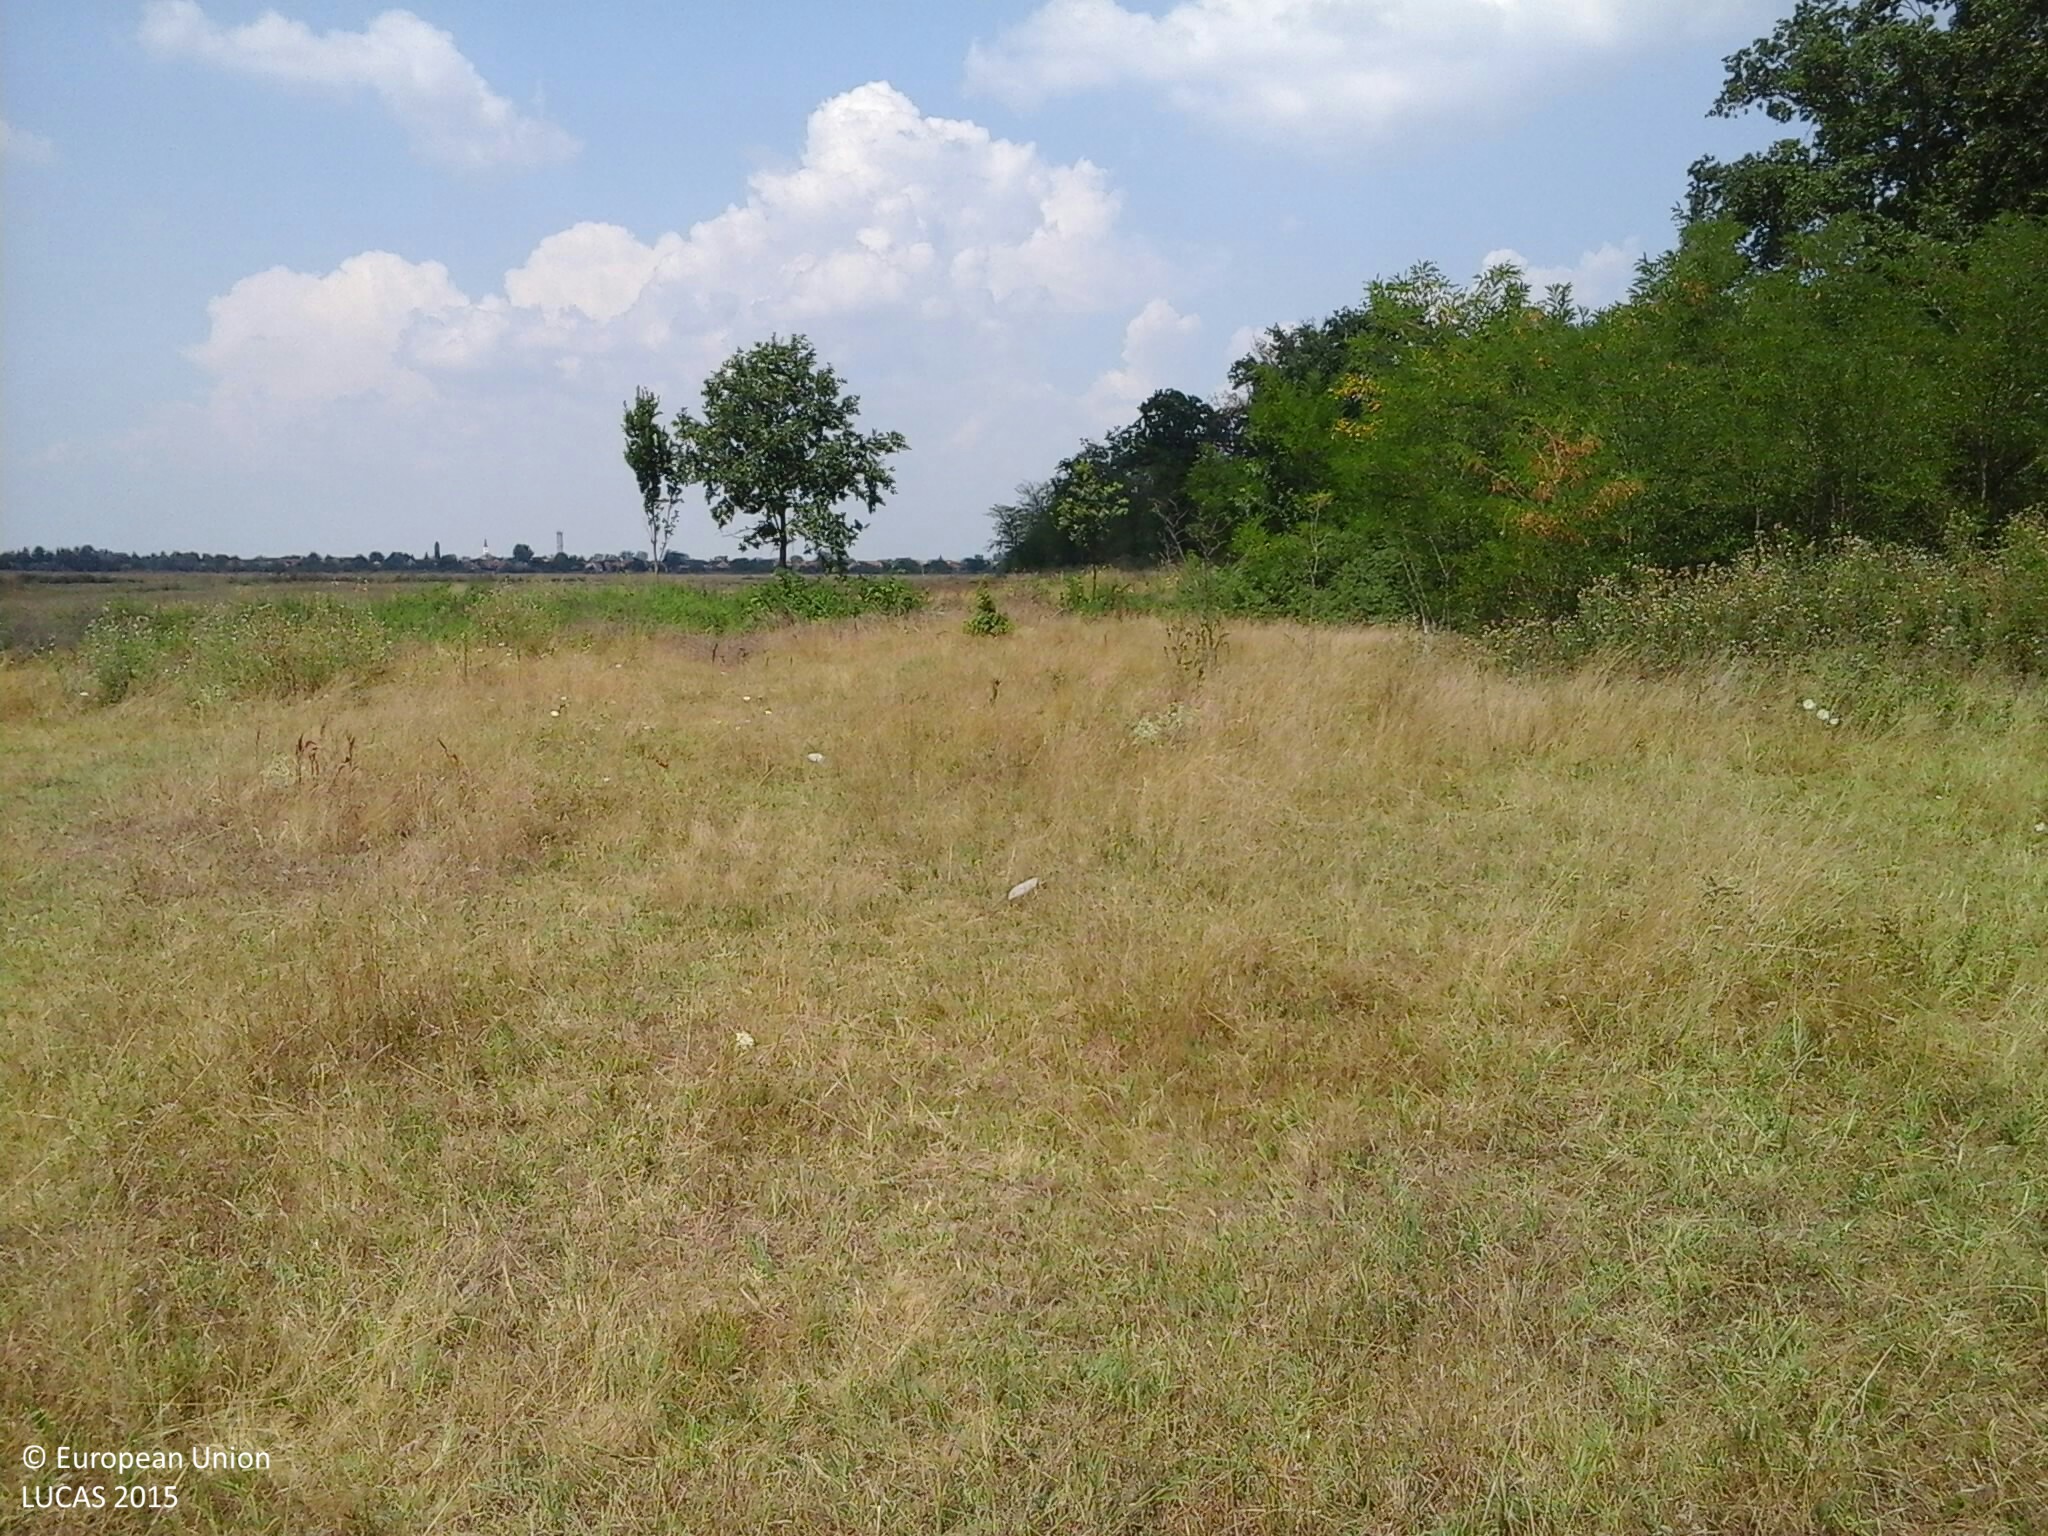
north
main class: Grassland
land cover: Grassland with sparse tree/shrub cover
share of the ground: > 75 %
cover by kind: herbaceous plants 90 %, broadleaved forest trees 5 %, shrubs 5 %
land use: Agriculture (excluding fallow land and kitchen gardens)
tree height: < 5 m
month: August
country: HU
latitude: 47.6083
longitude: 20.9042
